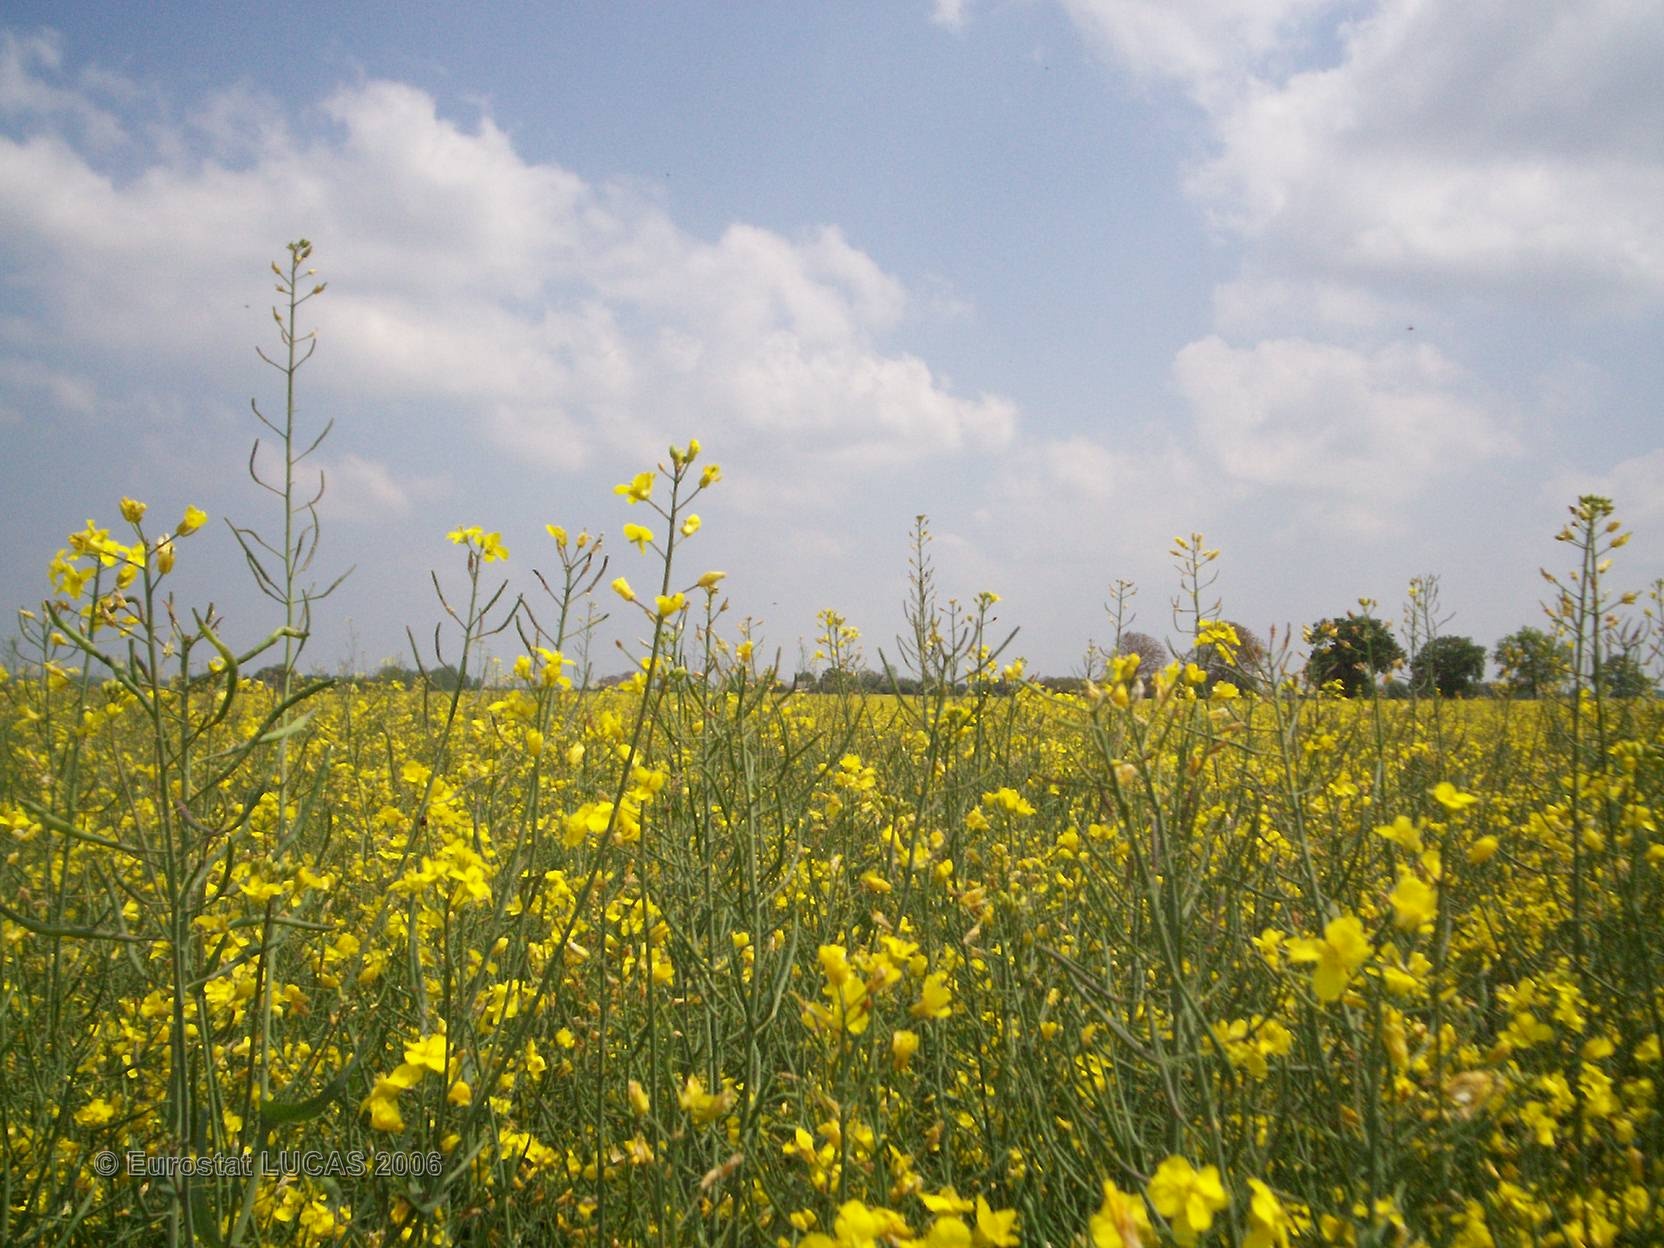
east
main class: Cropland
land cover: Rape and turnip rape
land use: Agriculture (excluding fallow land and kitchen gardens)
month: May
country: FR
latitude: 47.4976
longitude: 0.2192
